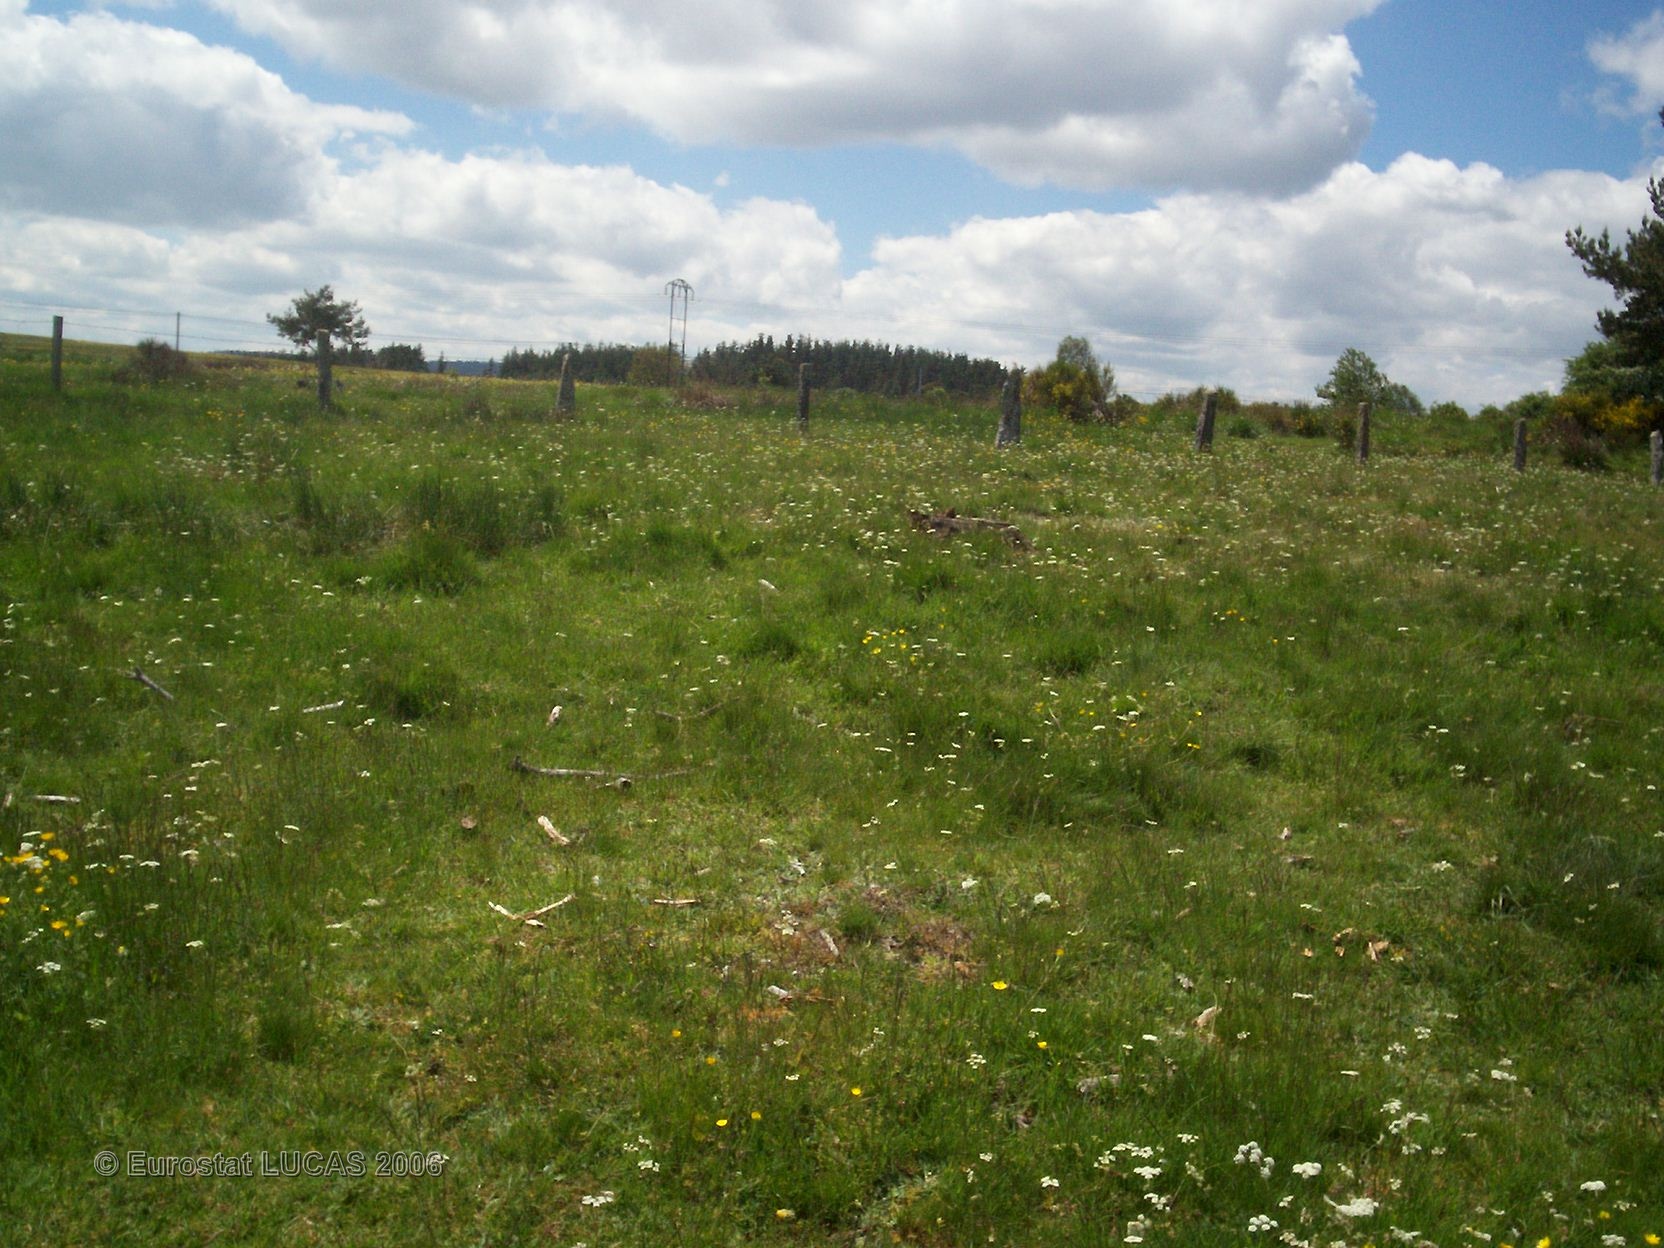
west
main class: Grassland
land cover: Grassland without tree/shrub cover
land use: Agriculture (excluding fallow land and kitchen gardens)
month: May
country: FR
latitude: 44.7667
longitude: 3.2948
